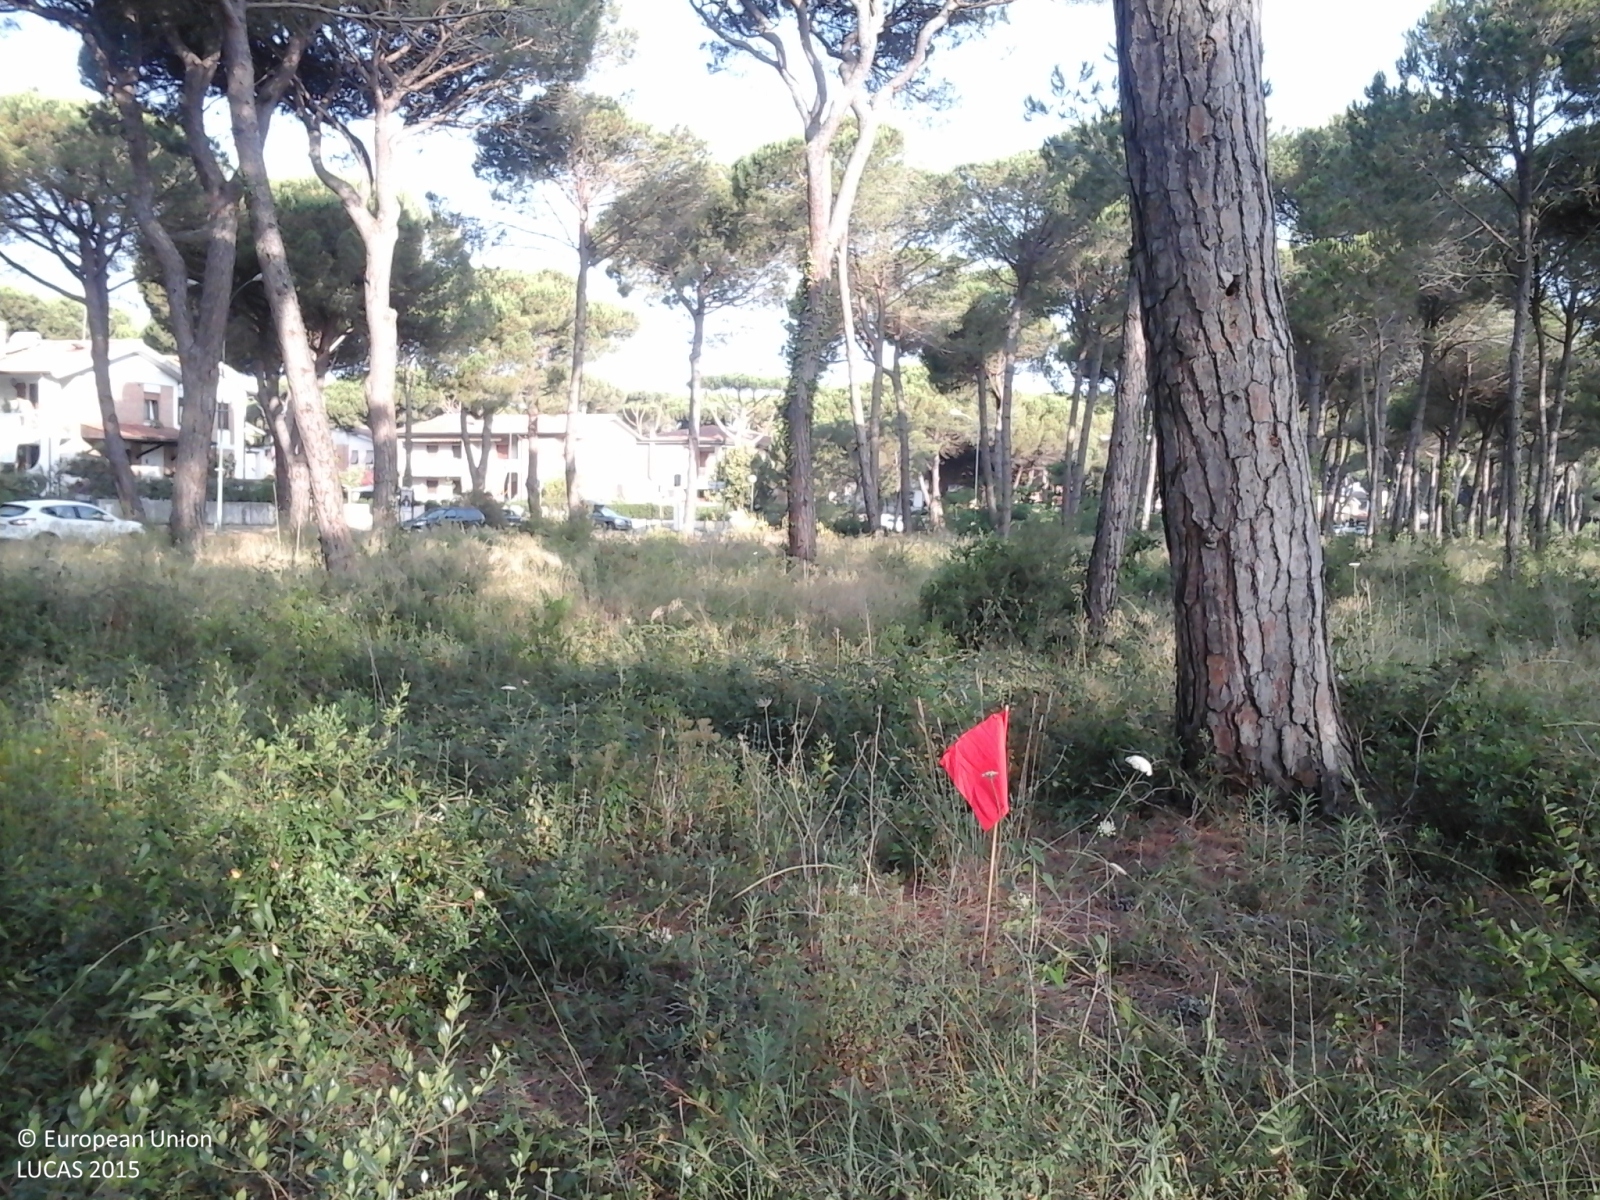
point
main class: Woodland
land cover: Pine dominated coniferous woodland
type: broadleaved evergreen forest
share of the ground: > 75 %
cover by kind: coniferous forest trees 80 %, shrubs 10 %, herbaceous plants 10 %
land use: Forestry
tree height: > 5 m
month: July
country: IT
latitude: 42.7215
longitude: 10.9859
